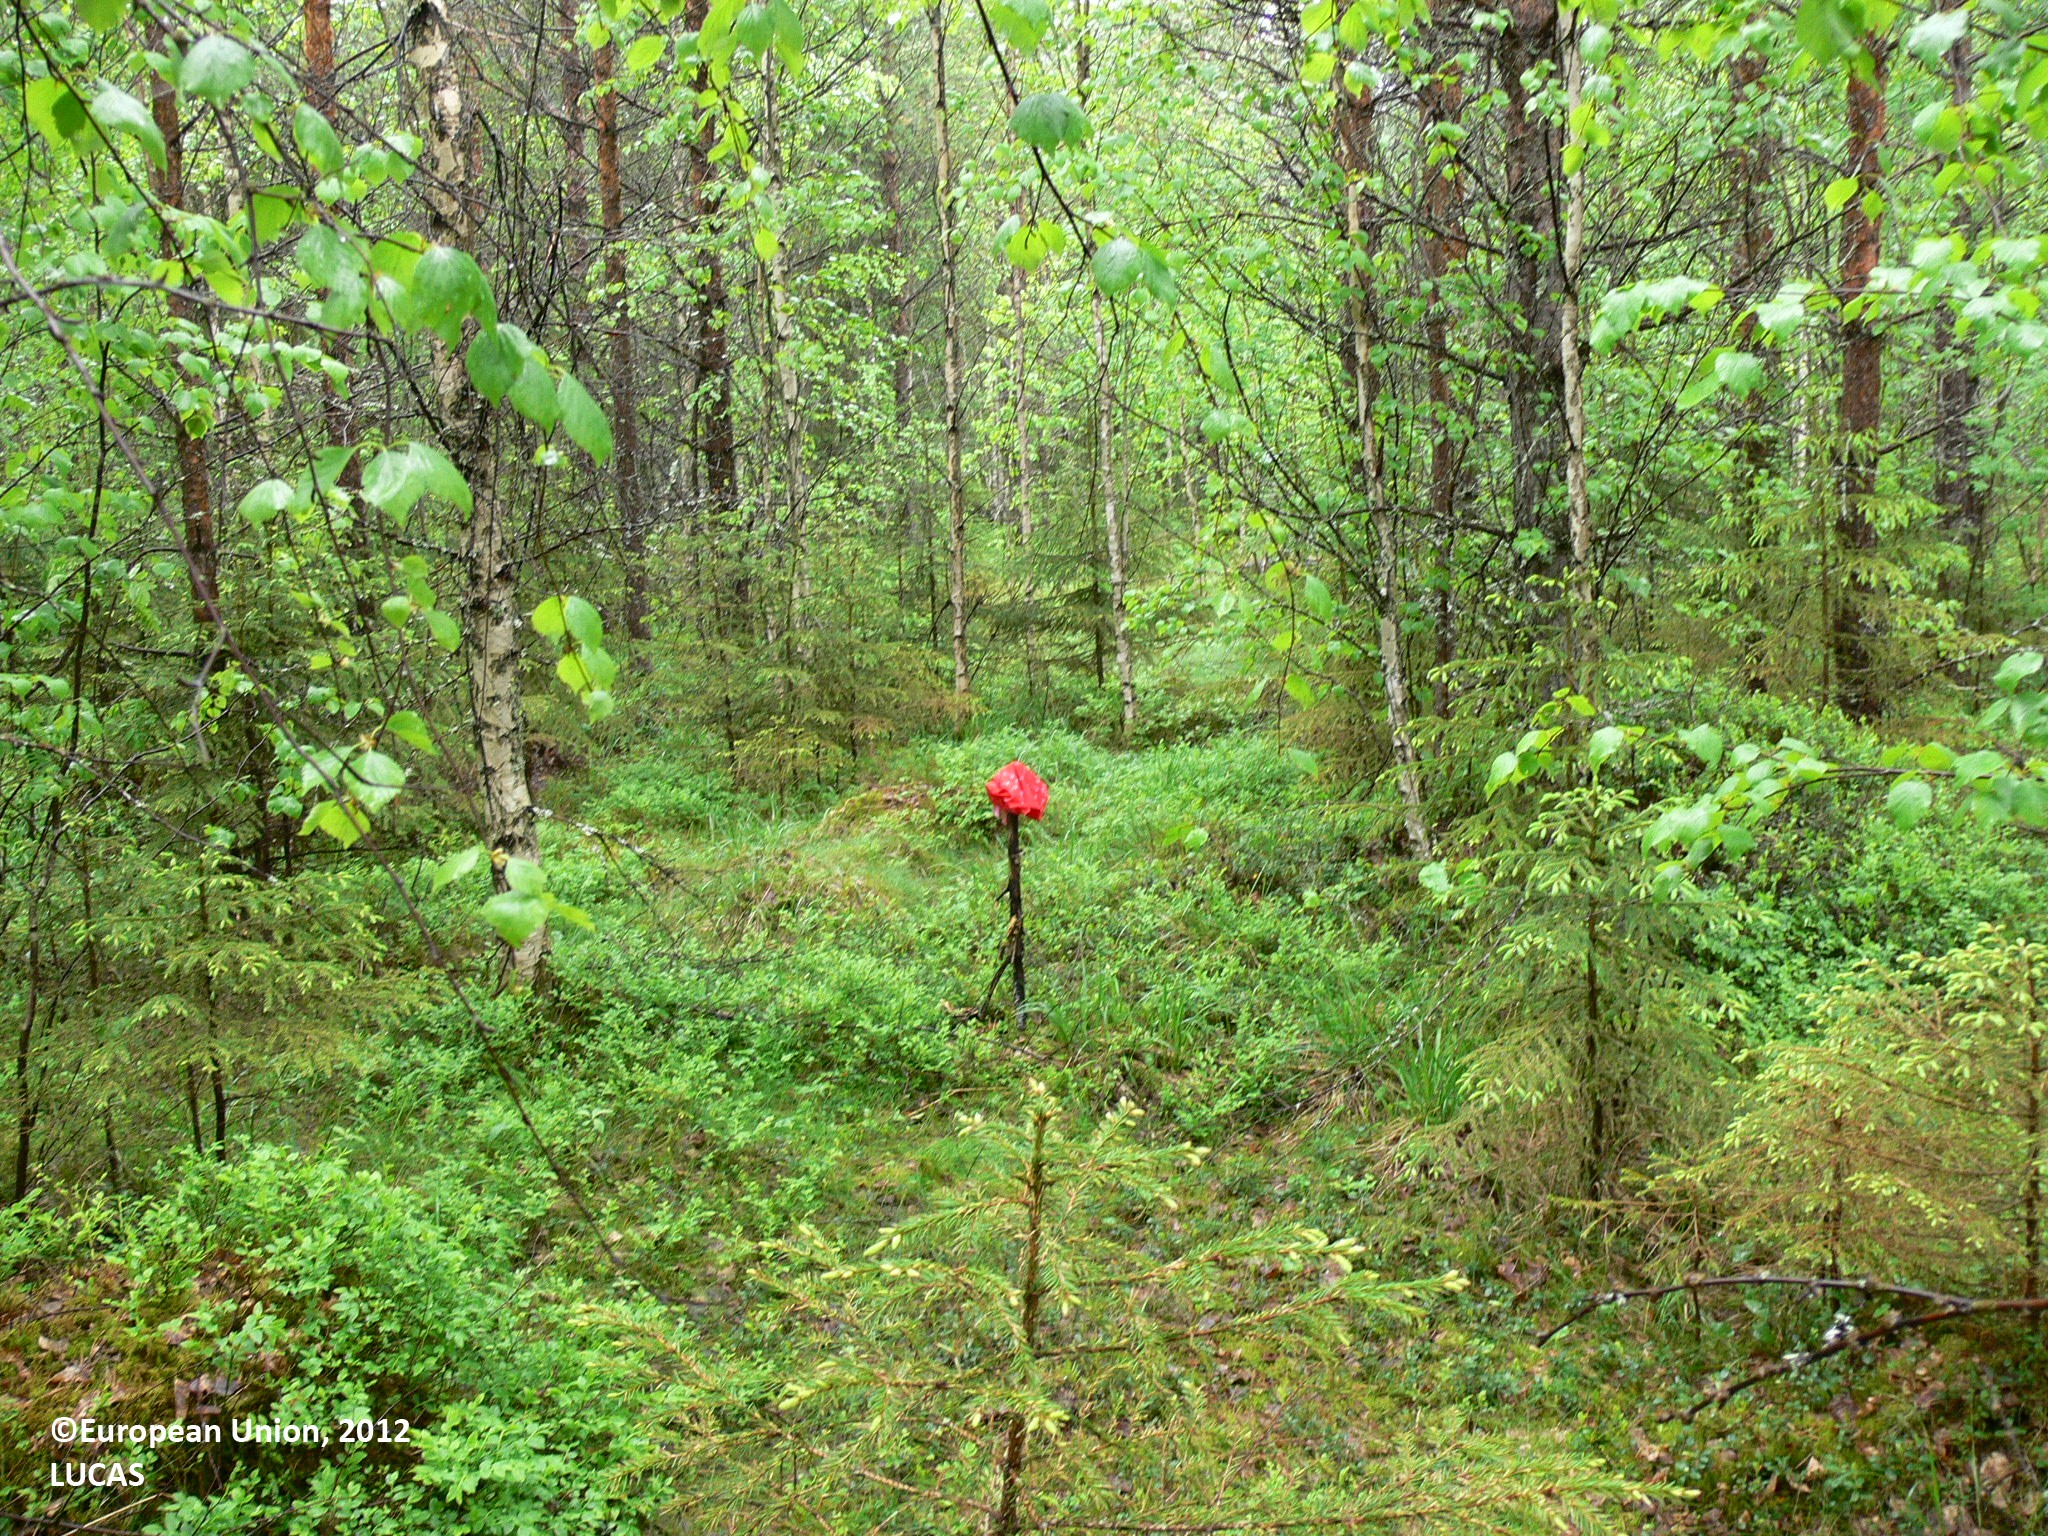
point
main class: Woodland
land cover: Other mixed woodland
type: boreal forest
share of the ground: > 75 %
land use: Forestry
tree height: > 5 m
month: June
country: FI
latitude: 62.5284
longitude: 30.3476
